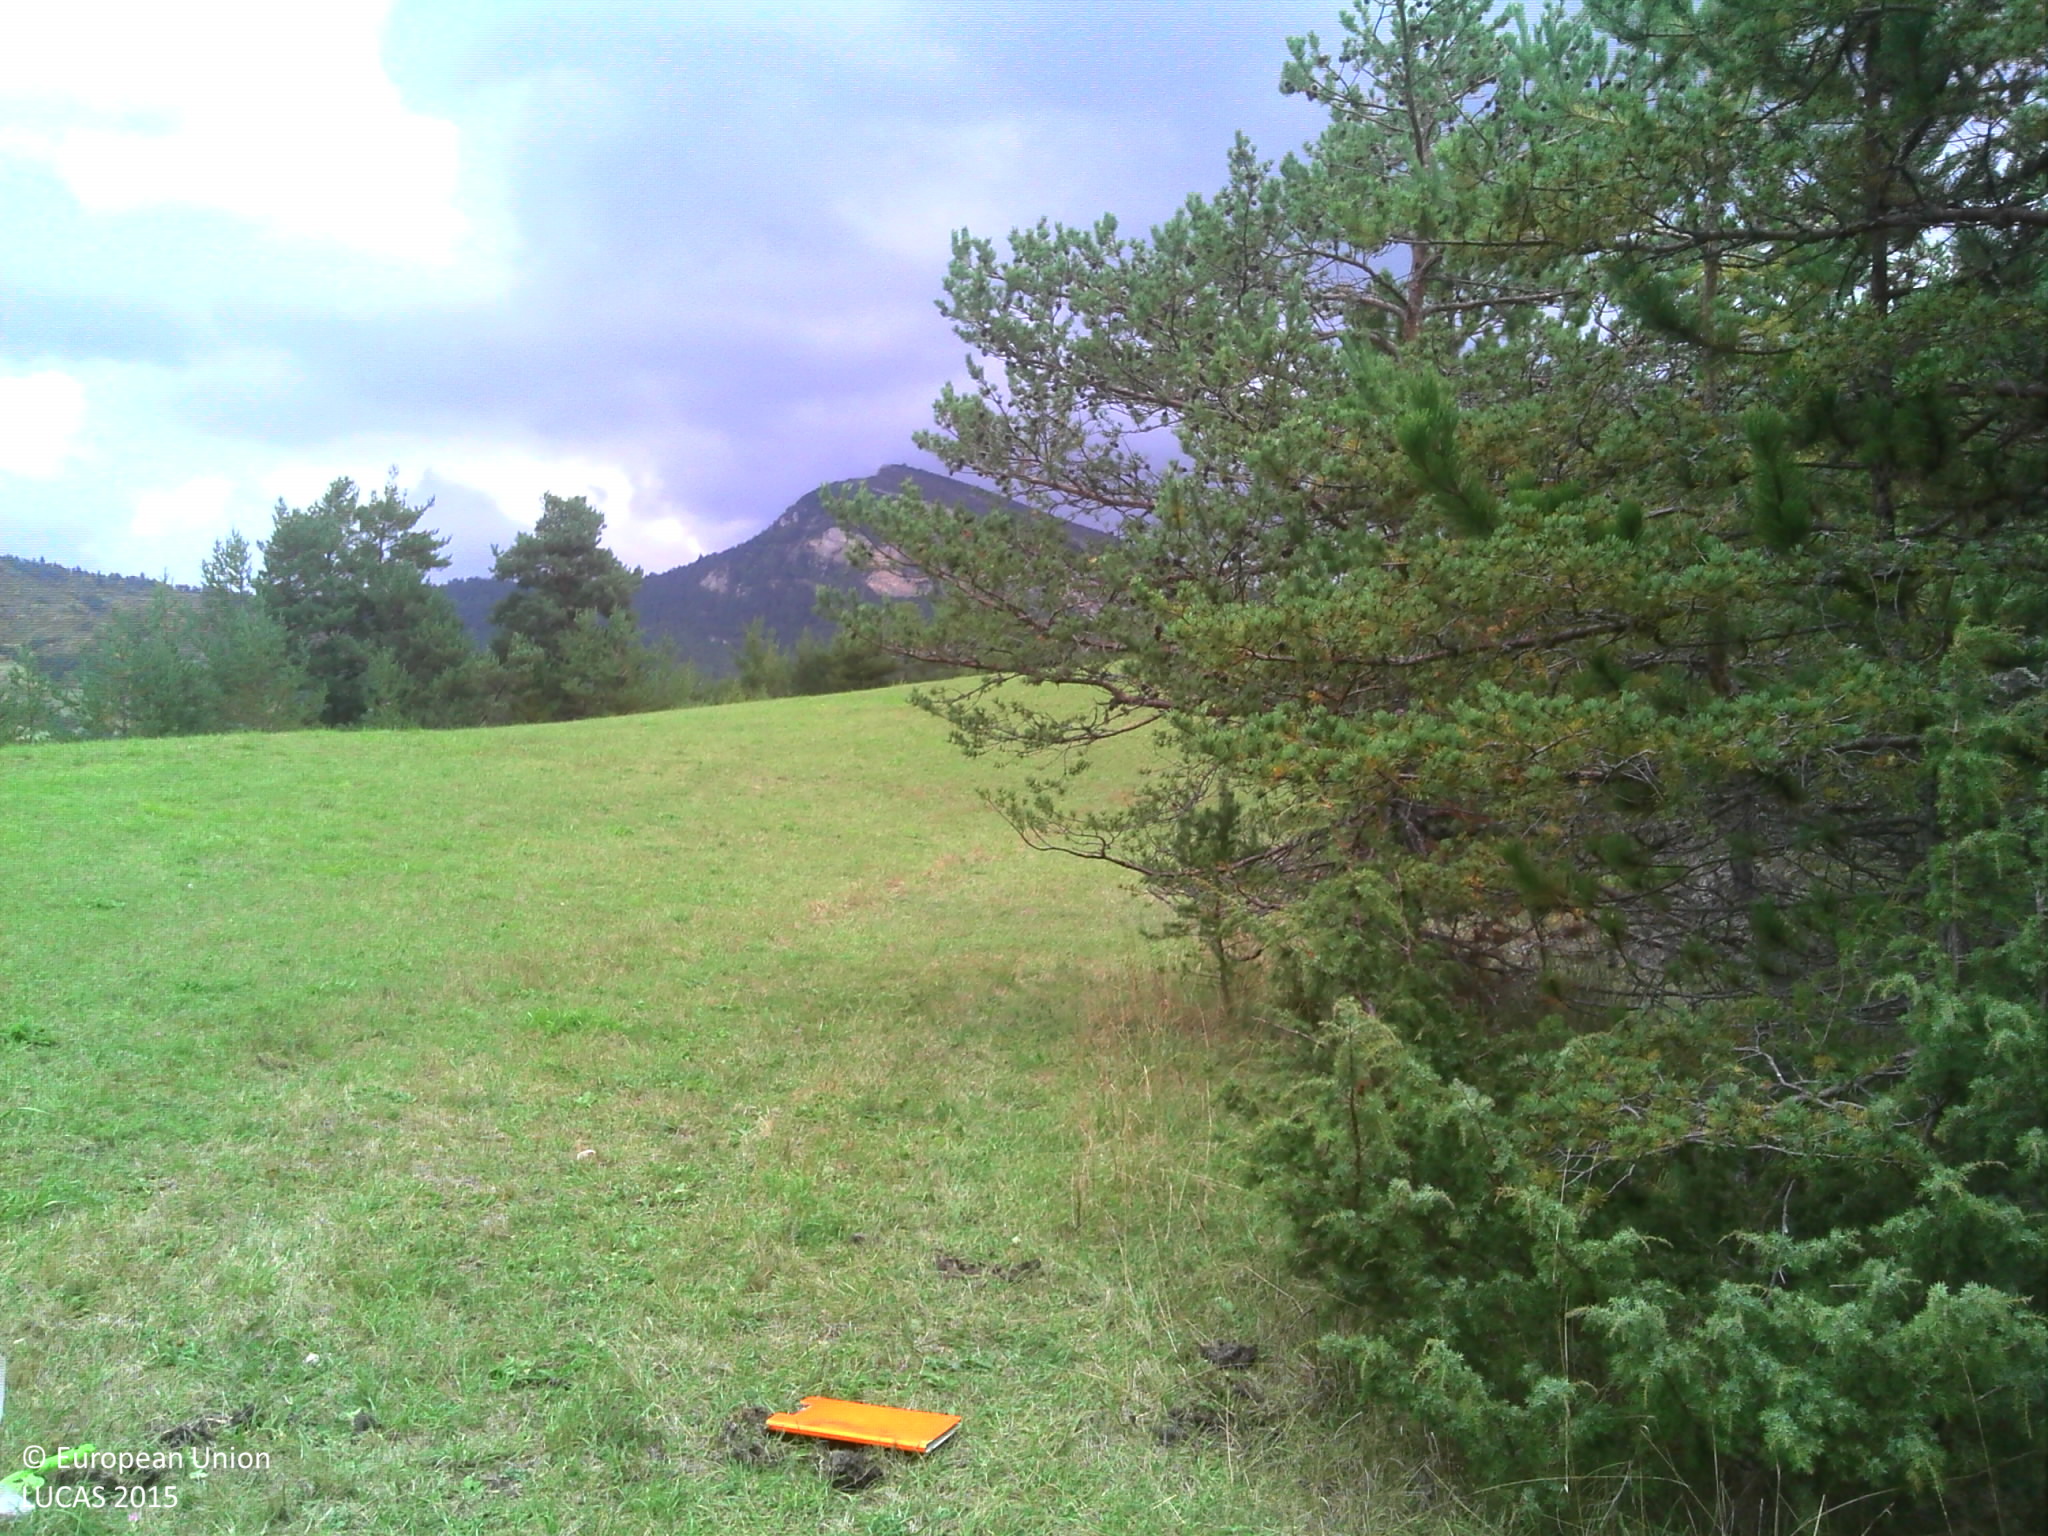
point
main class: Grassland
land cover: Grassland without tree/shrub cover
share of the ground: > 75 %
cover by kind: herbaceous plants 95 %, shrubs 5 %
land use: Agriculture (excluding fallow land and kitchen gardens)
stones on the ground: > 50 %
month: September
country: FR
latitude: 44.5055
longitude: 5.4914
